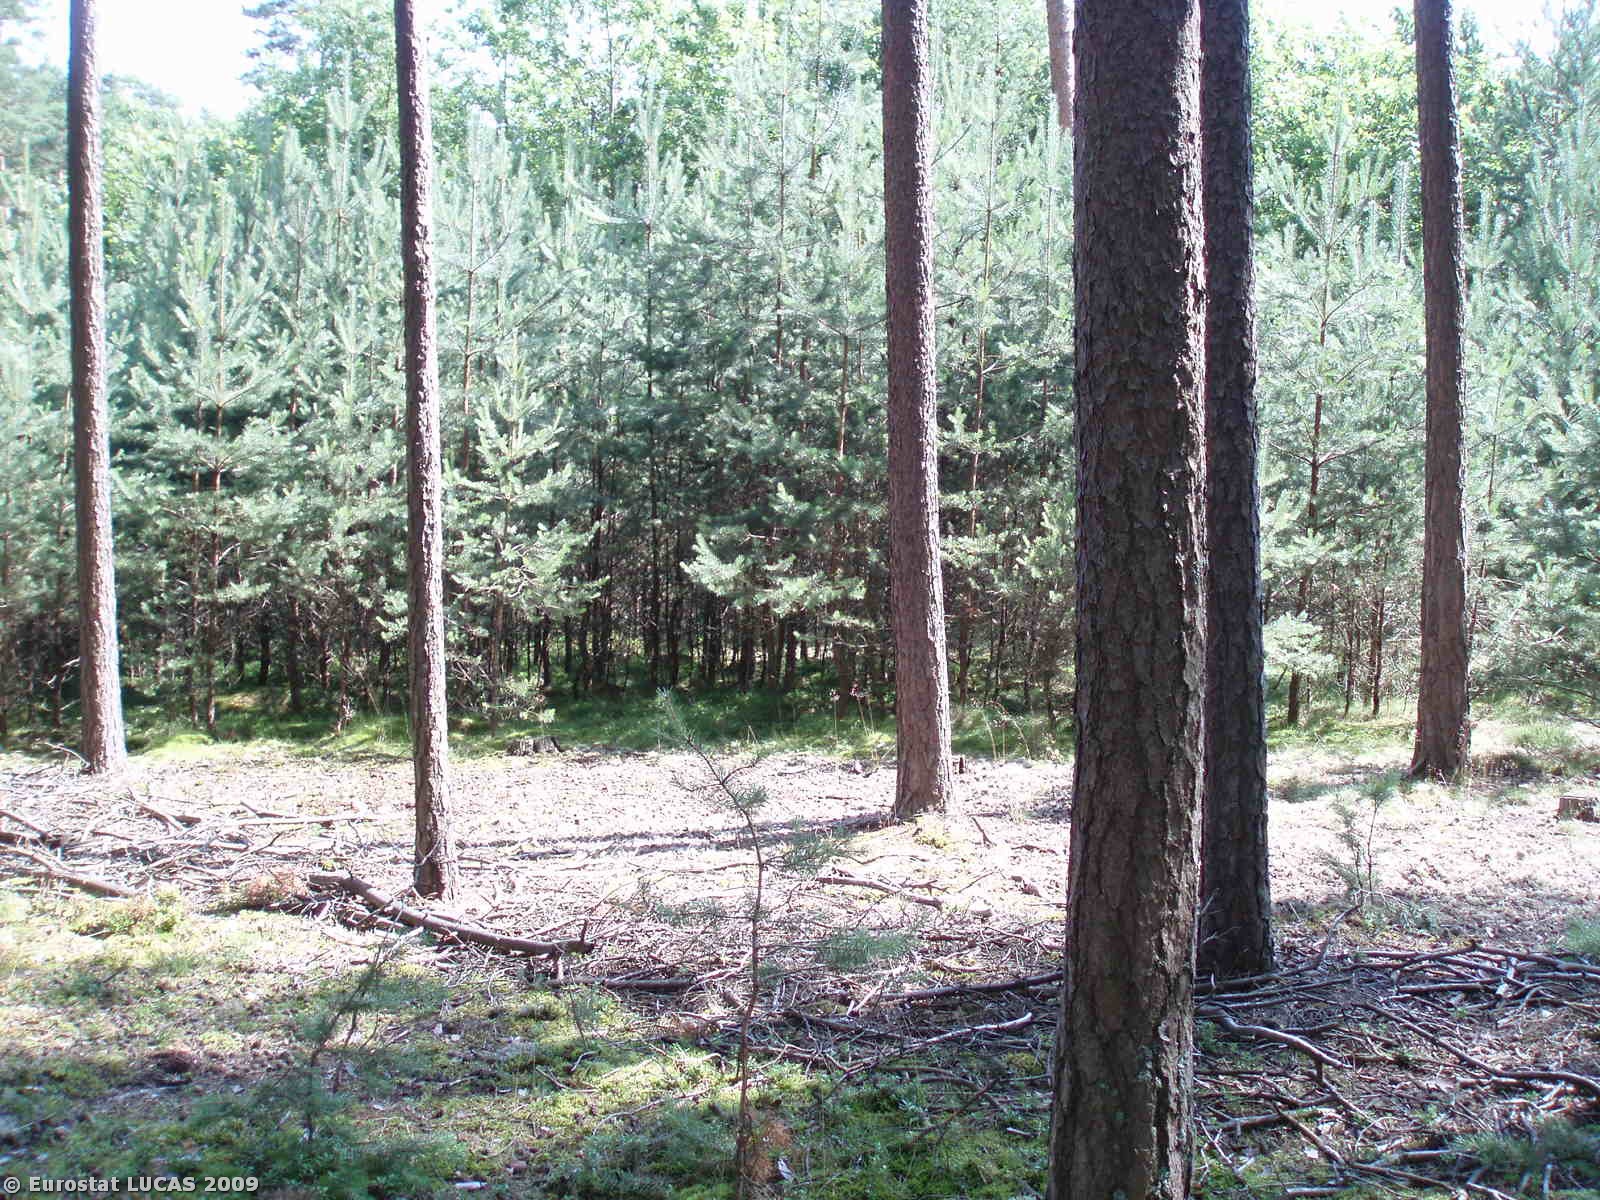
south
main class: Woodland
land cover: Coniferous woodland
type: hemiboreal forest and nemoral coniferous forest and mixed broadleaved-coniferous forest
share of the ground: > 75 %
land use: Forestry
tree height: > 5 m
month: July
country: CZ
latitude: 49.6796
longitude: 12.8963
